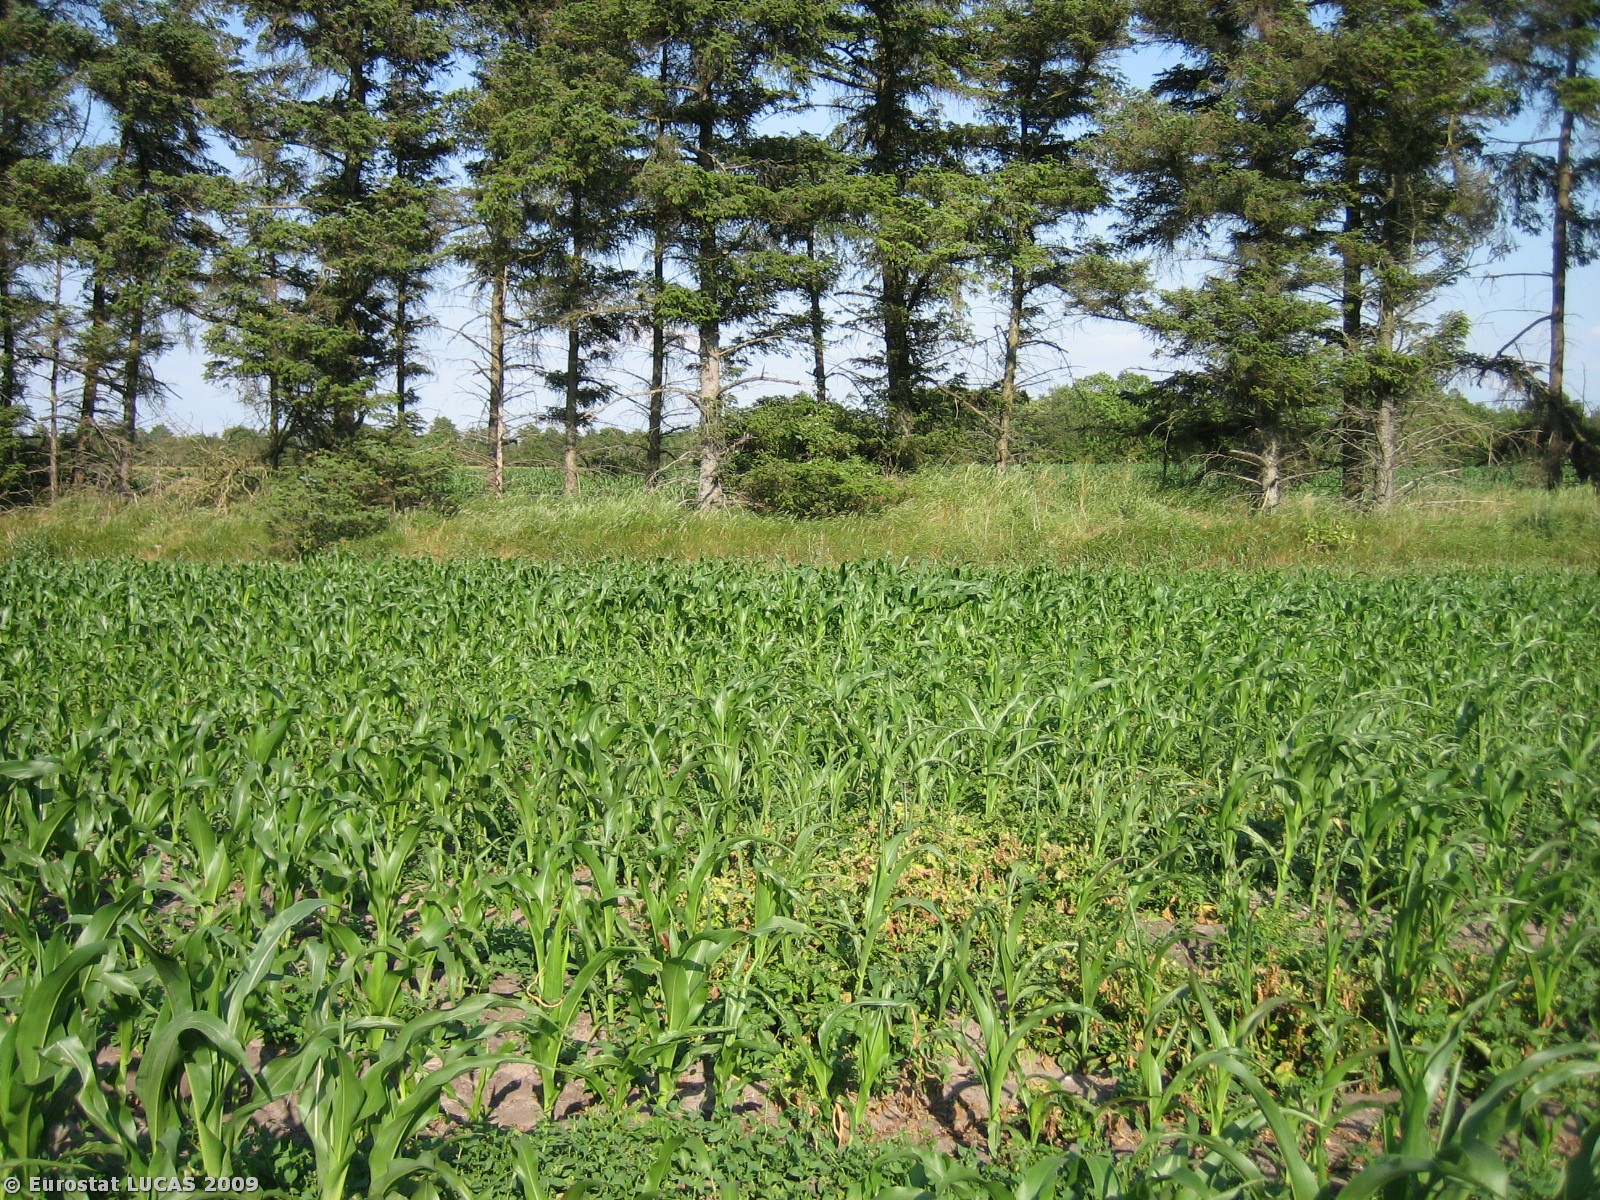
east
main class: Cropland
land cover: Maize
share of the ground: 25 - 50 %
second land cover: Dry pulses
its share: 50 - 75 %
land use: Agriculture (excluding fallow land and kitchen gardens)
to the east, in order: Maize; Dry pulses; Coniferous woodland; Maize; Barley
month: July
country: DK
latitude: 55.3380
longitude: 8.8816
